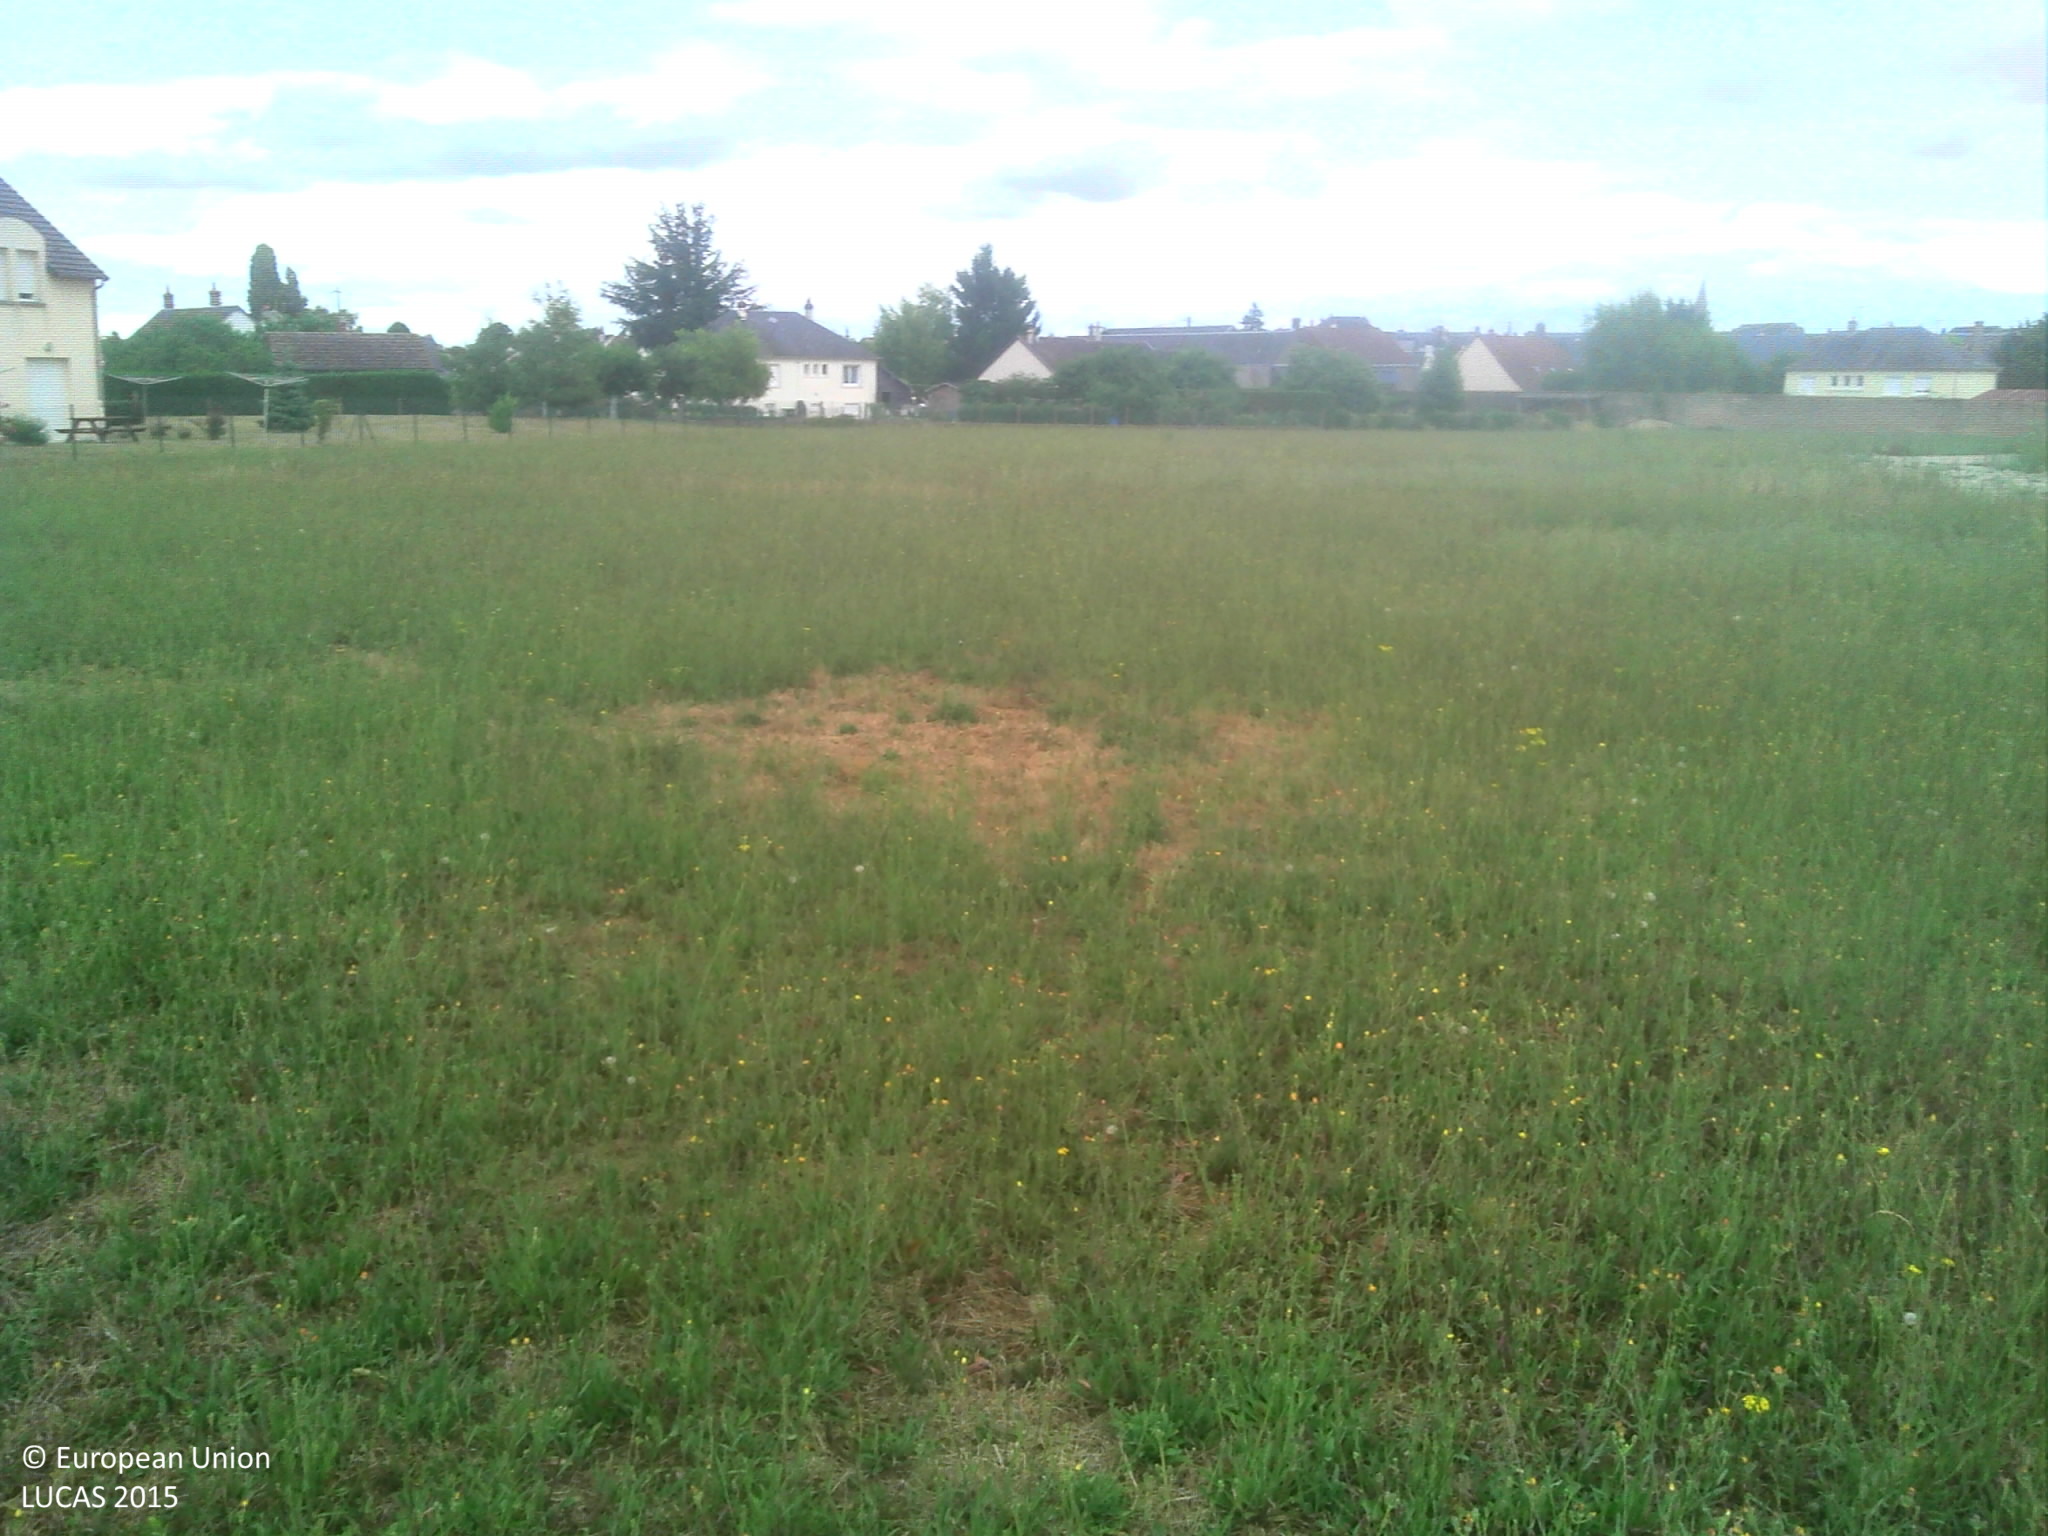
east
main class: Grassland
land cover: Grassland without tree/shrub cover
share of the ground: > 75 %
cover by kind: herbaceous plants 100 %
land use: Semi-natural and natural areas not in use
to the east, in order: Grassland without tree/shrub cover; Artificial constructions in urban areas
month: July
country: FR
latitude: 47.8238
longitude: 1.2880
